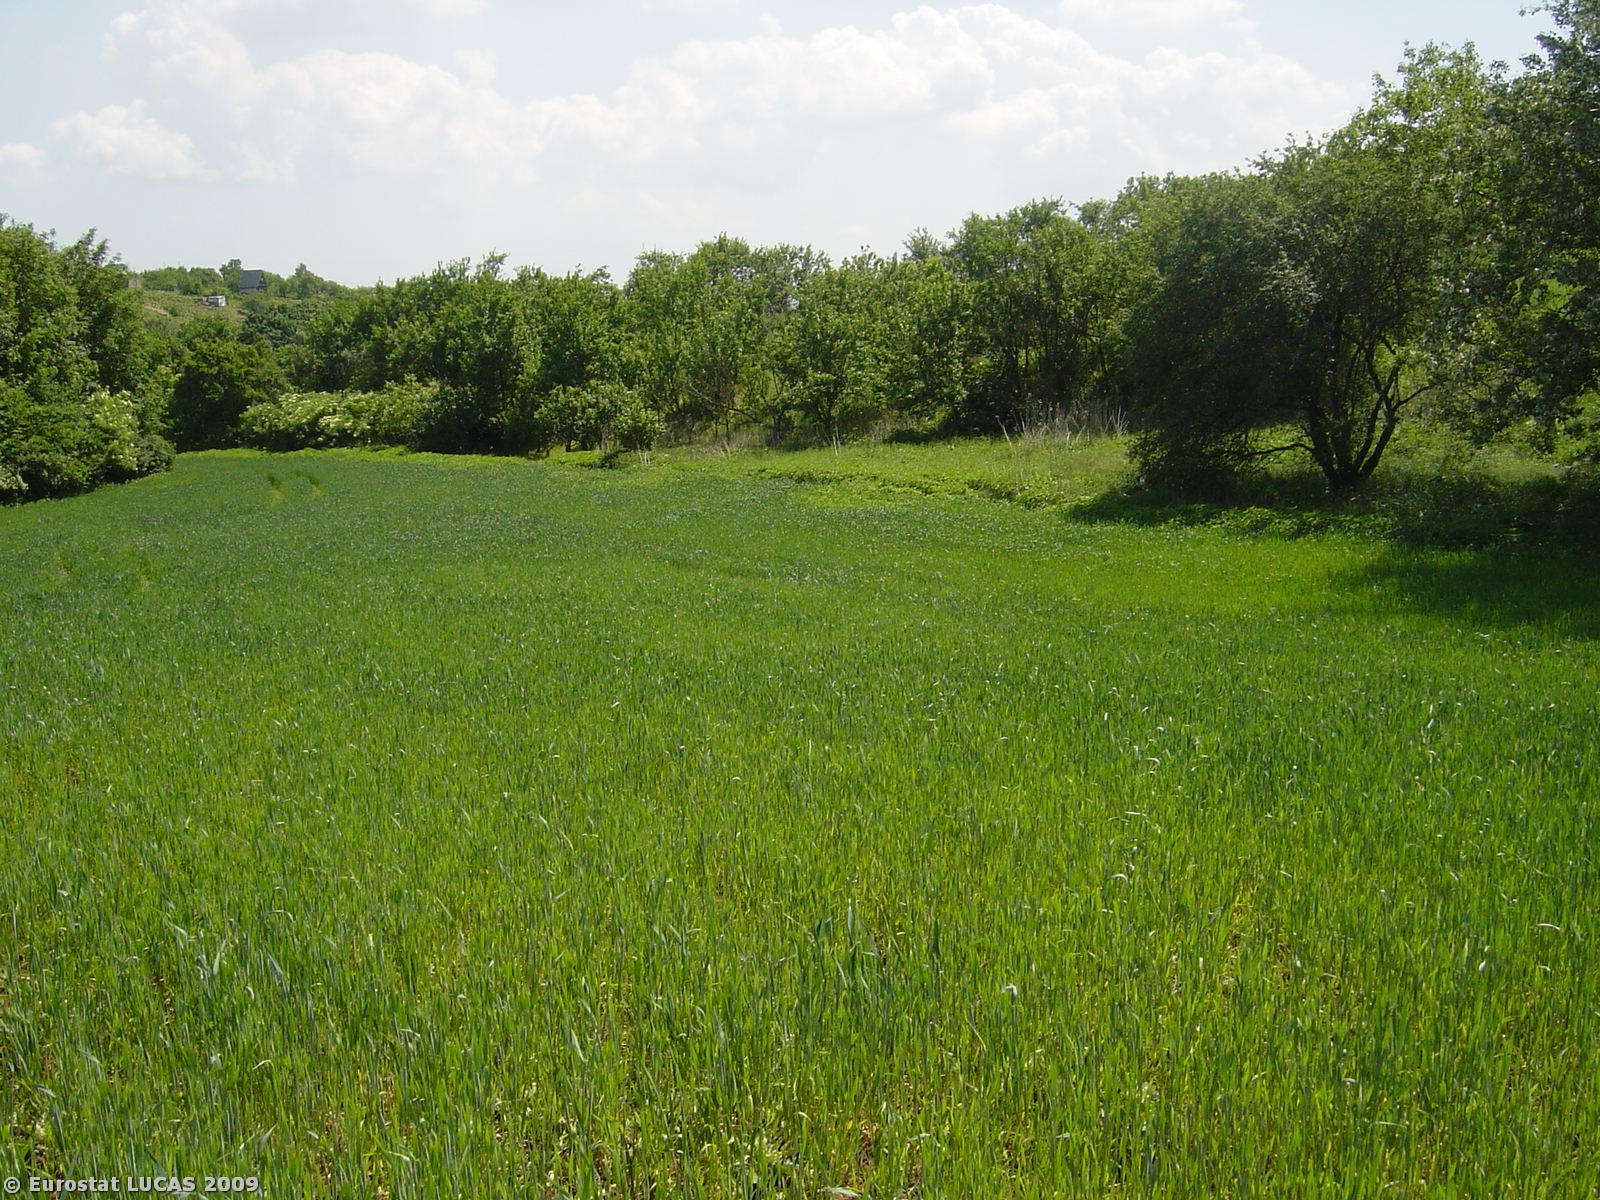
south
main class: Cropland
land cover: Common wheat
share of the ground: > 75 %
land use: Agriculture (excluding fallow land and kitchen gardens)
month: May
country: CZ
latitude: 49.0414
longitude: 17.1095
